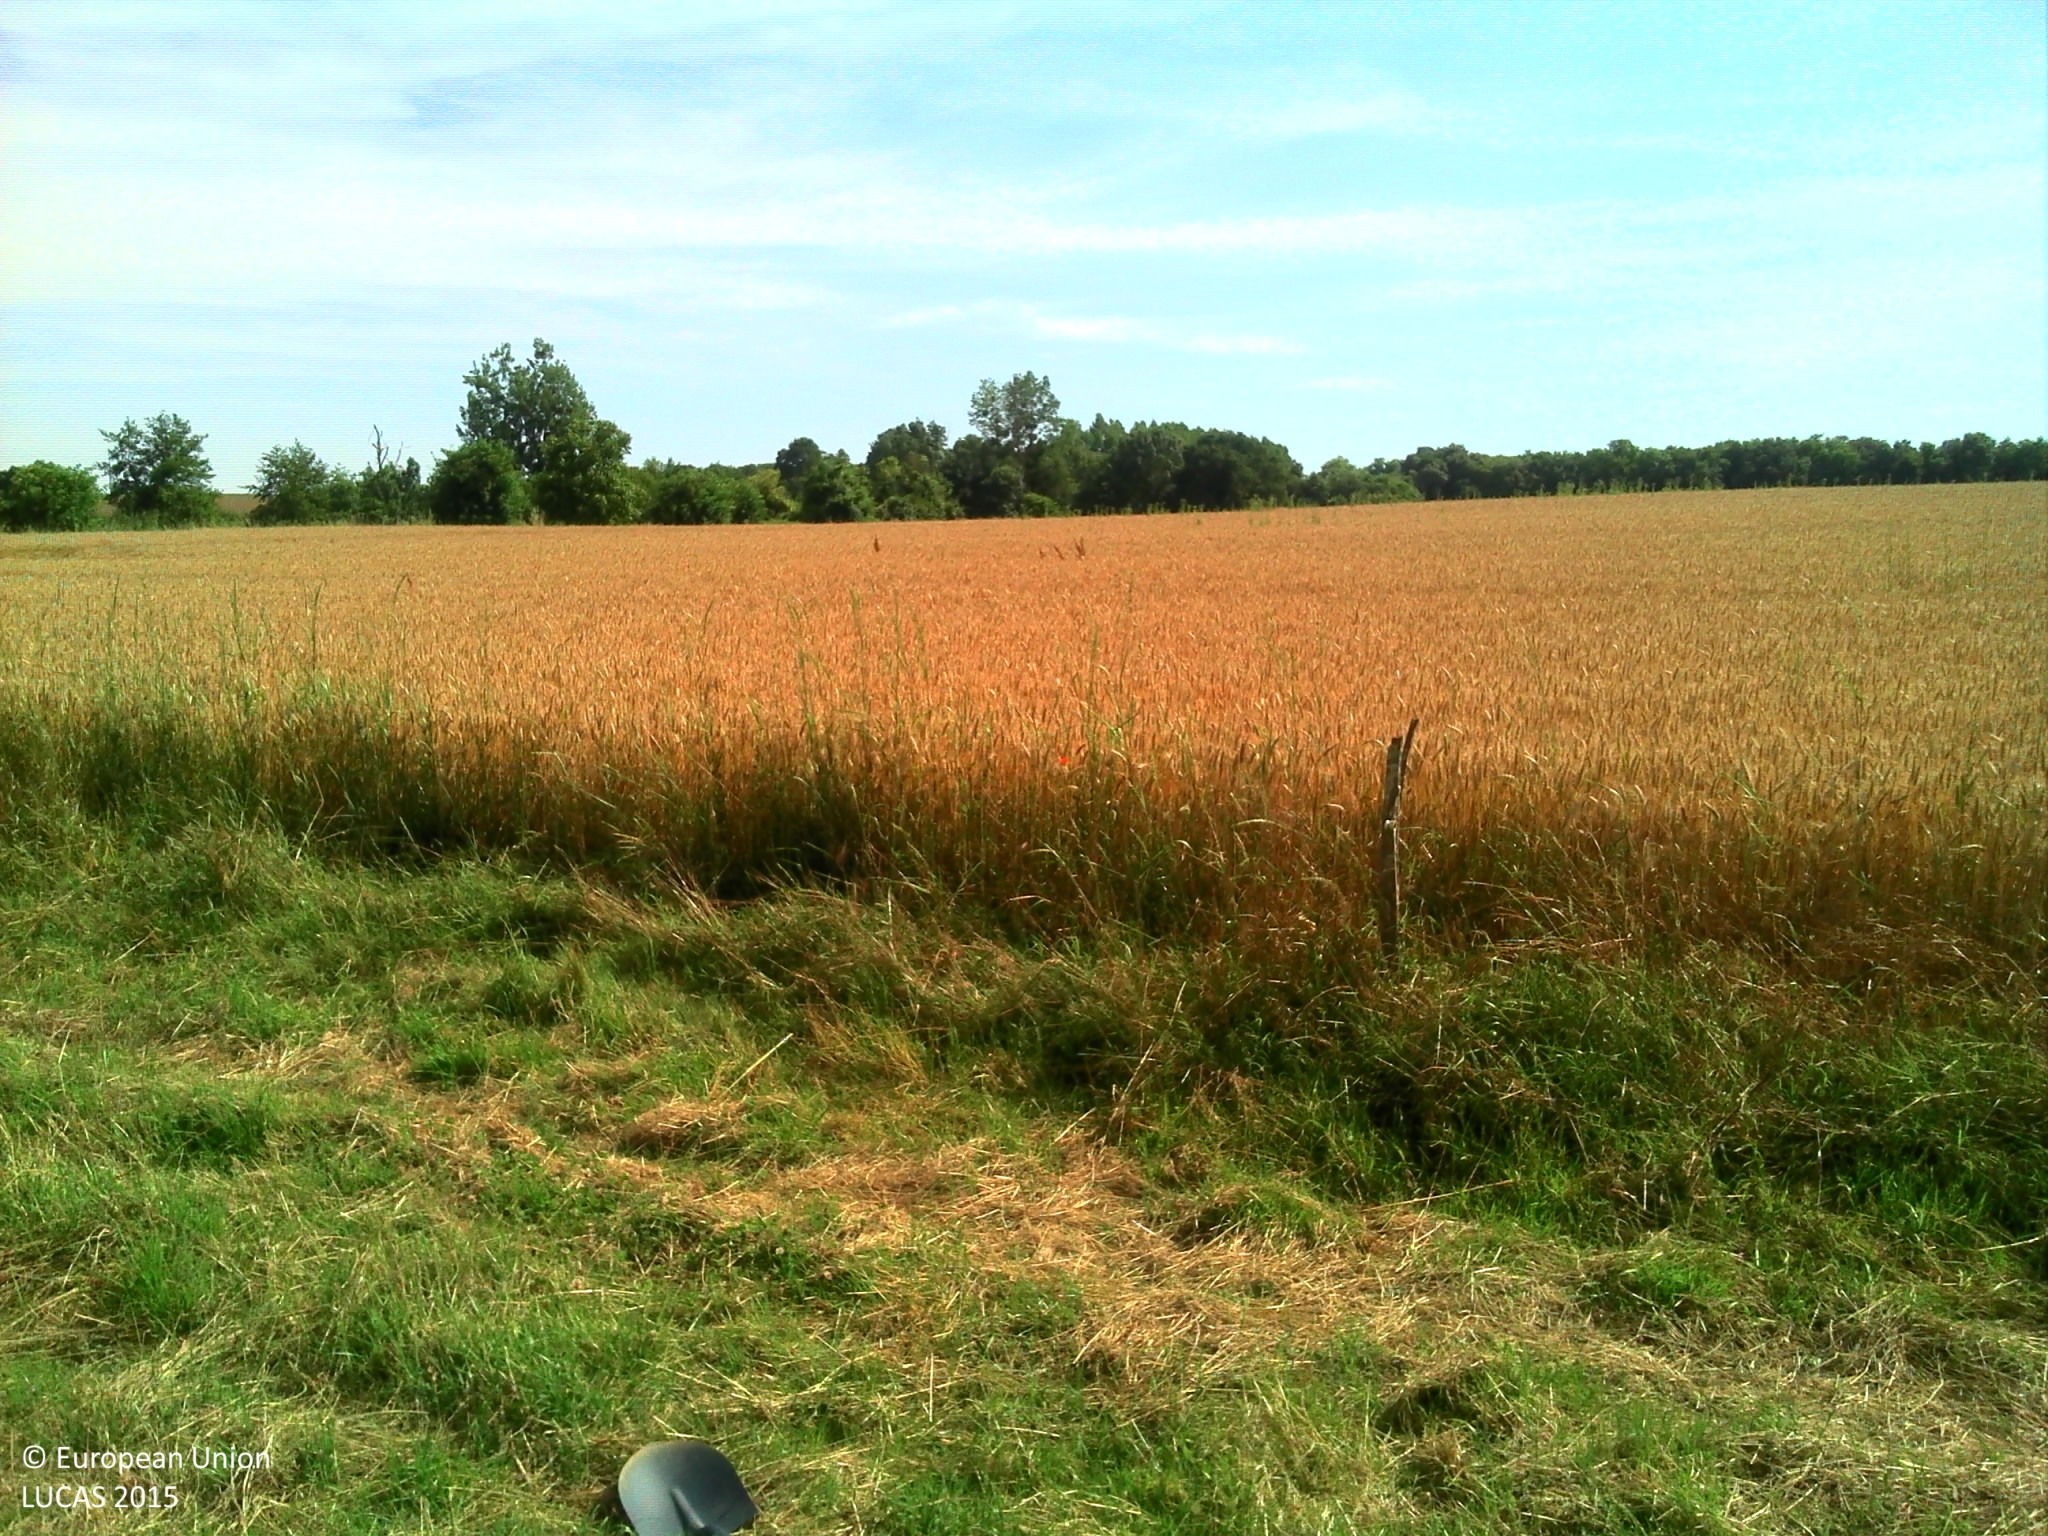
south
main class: Grassland
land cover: Grassland without tree/shrub cover
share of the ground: > 75 %
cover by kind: herbaceous plants 100 %
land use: Agriculture (excluding fallow land and kitchen gardens)
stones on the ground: < 10 %
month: June
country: FR
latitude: 45.8283
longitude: -0.9048
